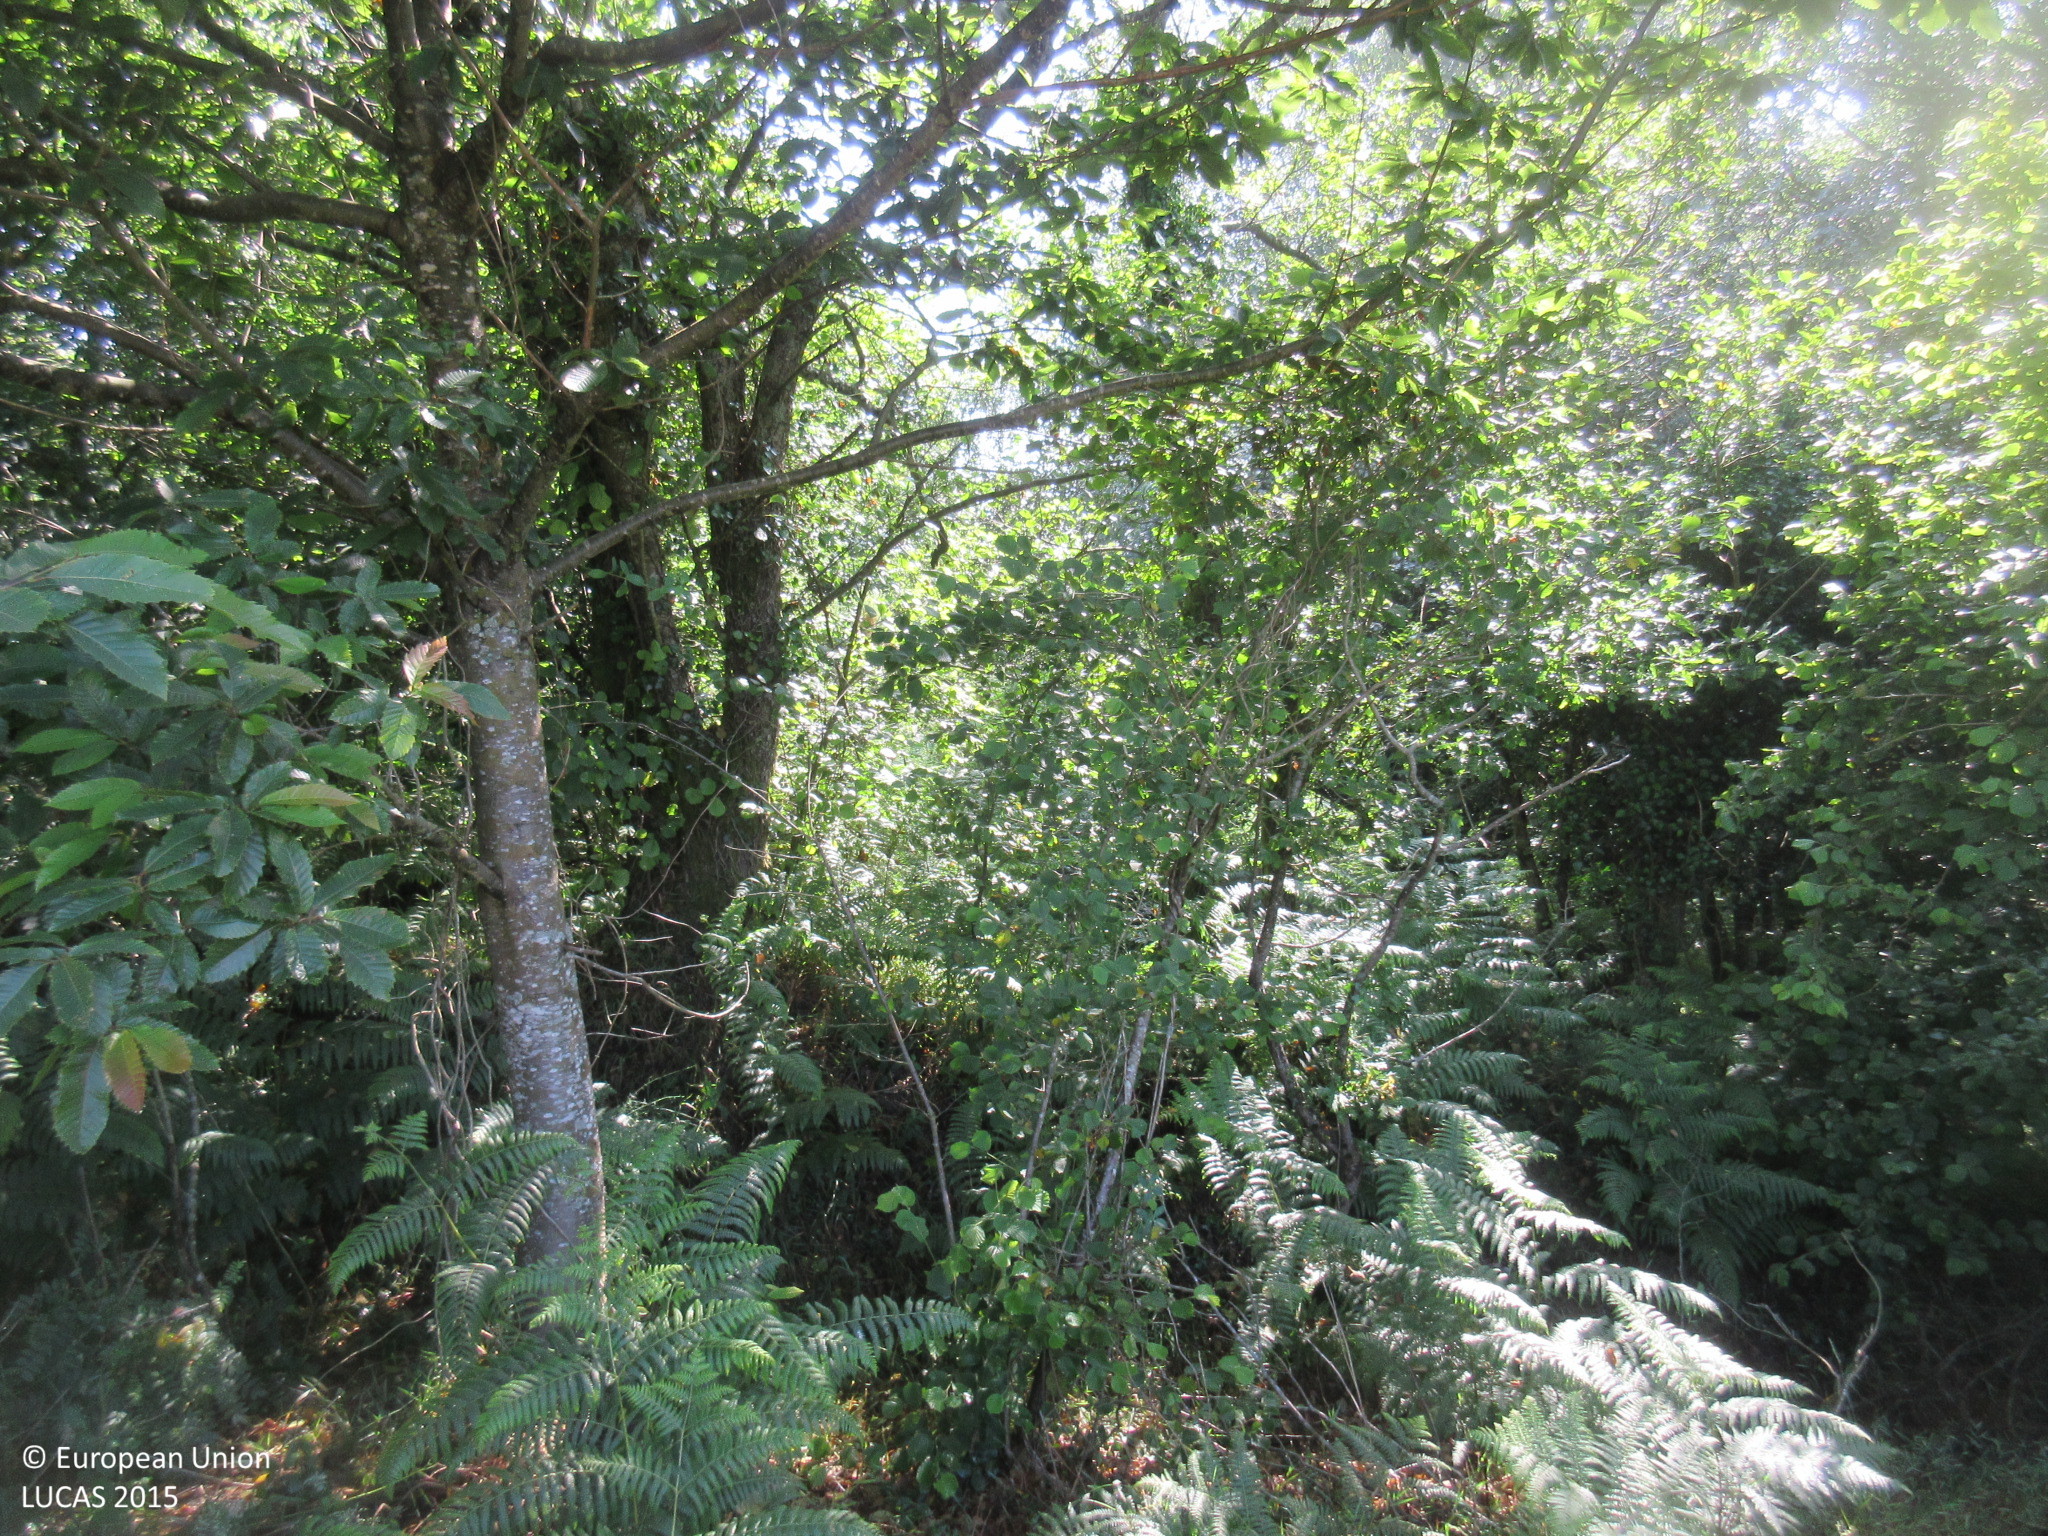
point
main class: Woodland
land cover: Broadleaved woodland
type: thermophilous deciduous forest
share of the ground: > 75 %
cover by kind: broadleaved forest trees 95 %, shrubs 5 %
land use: Forestry
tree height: > 5 m
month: July
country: ES
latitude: 43.3694
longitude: -6.3778
